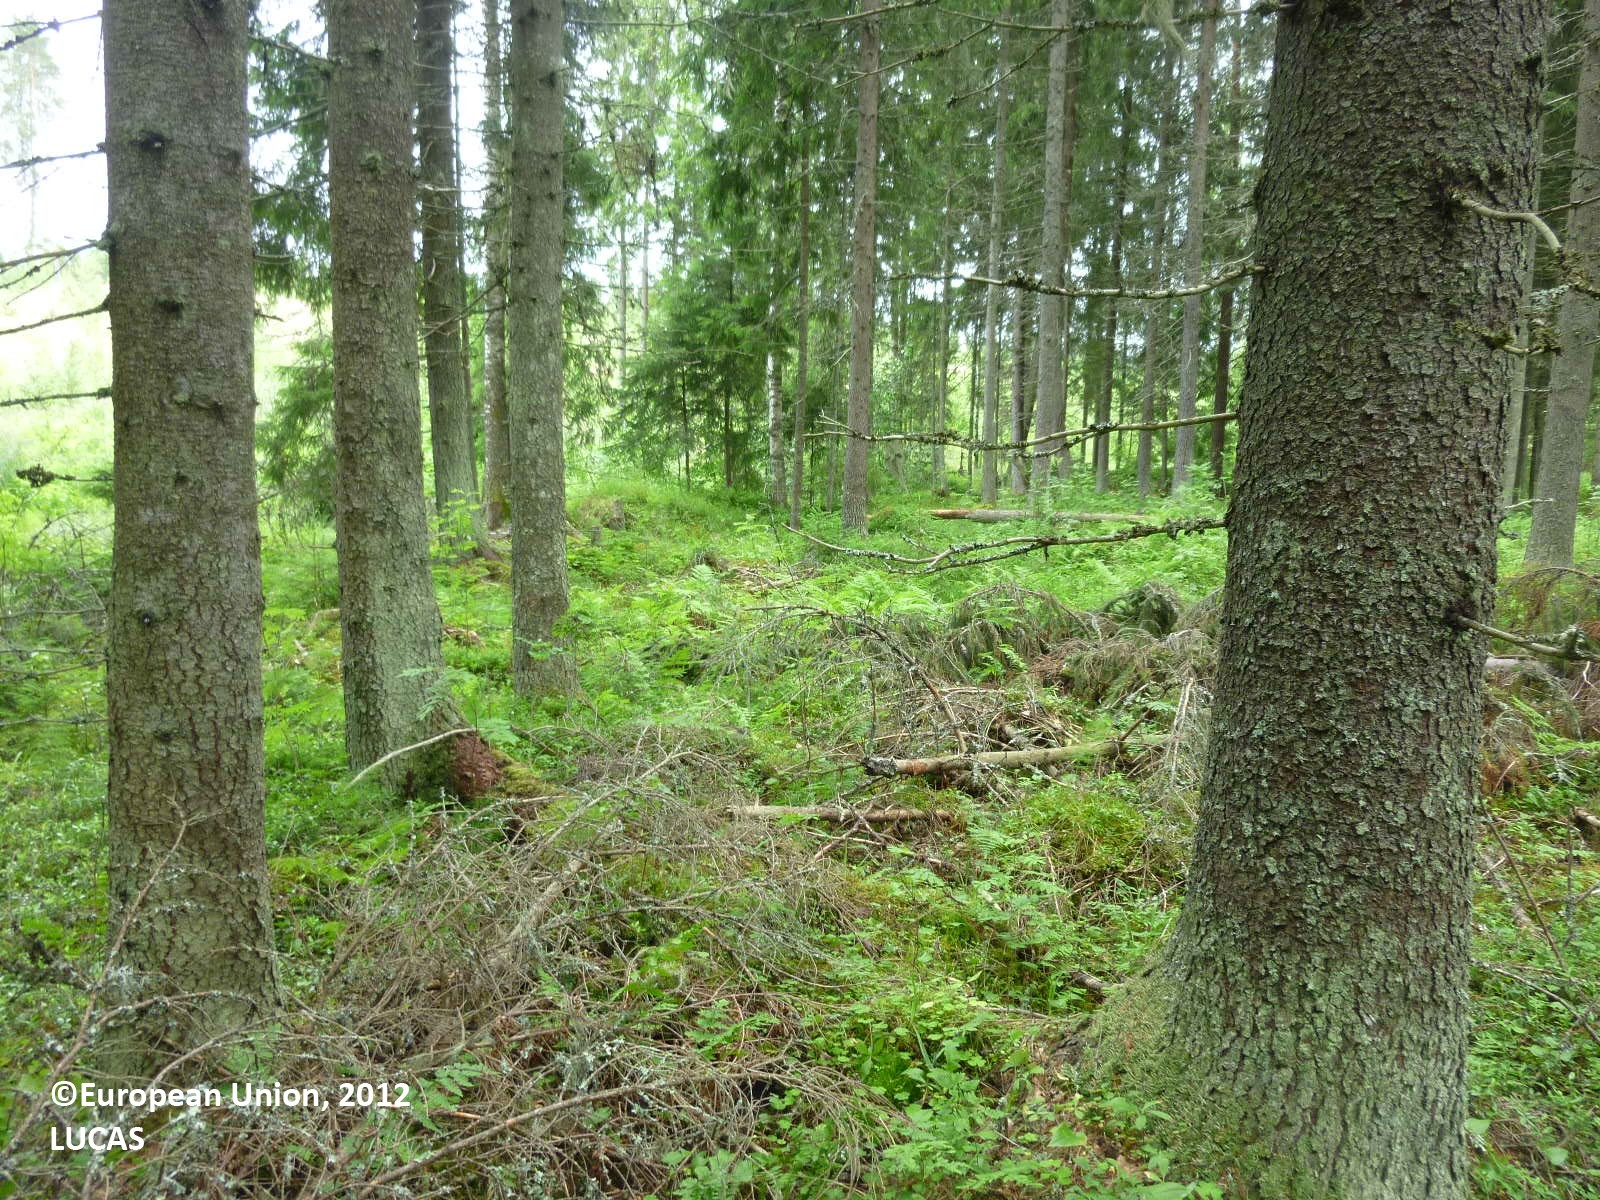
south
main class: Woodland
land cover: Spruce dominated coniferous woodland
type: boreal forest
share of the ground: > 75 %
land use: Forestry
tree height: > 5 m
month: July
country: FI
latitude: 61.7020
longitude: 22.1017
